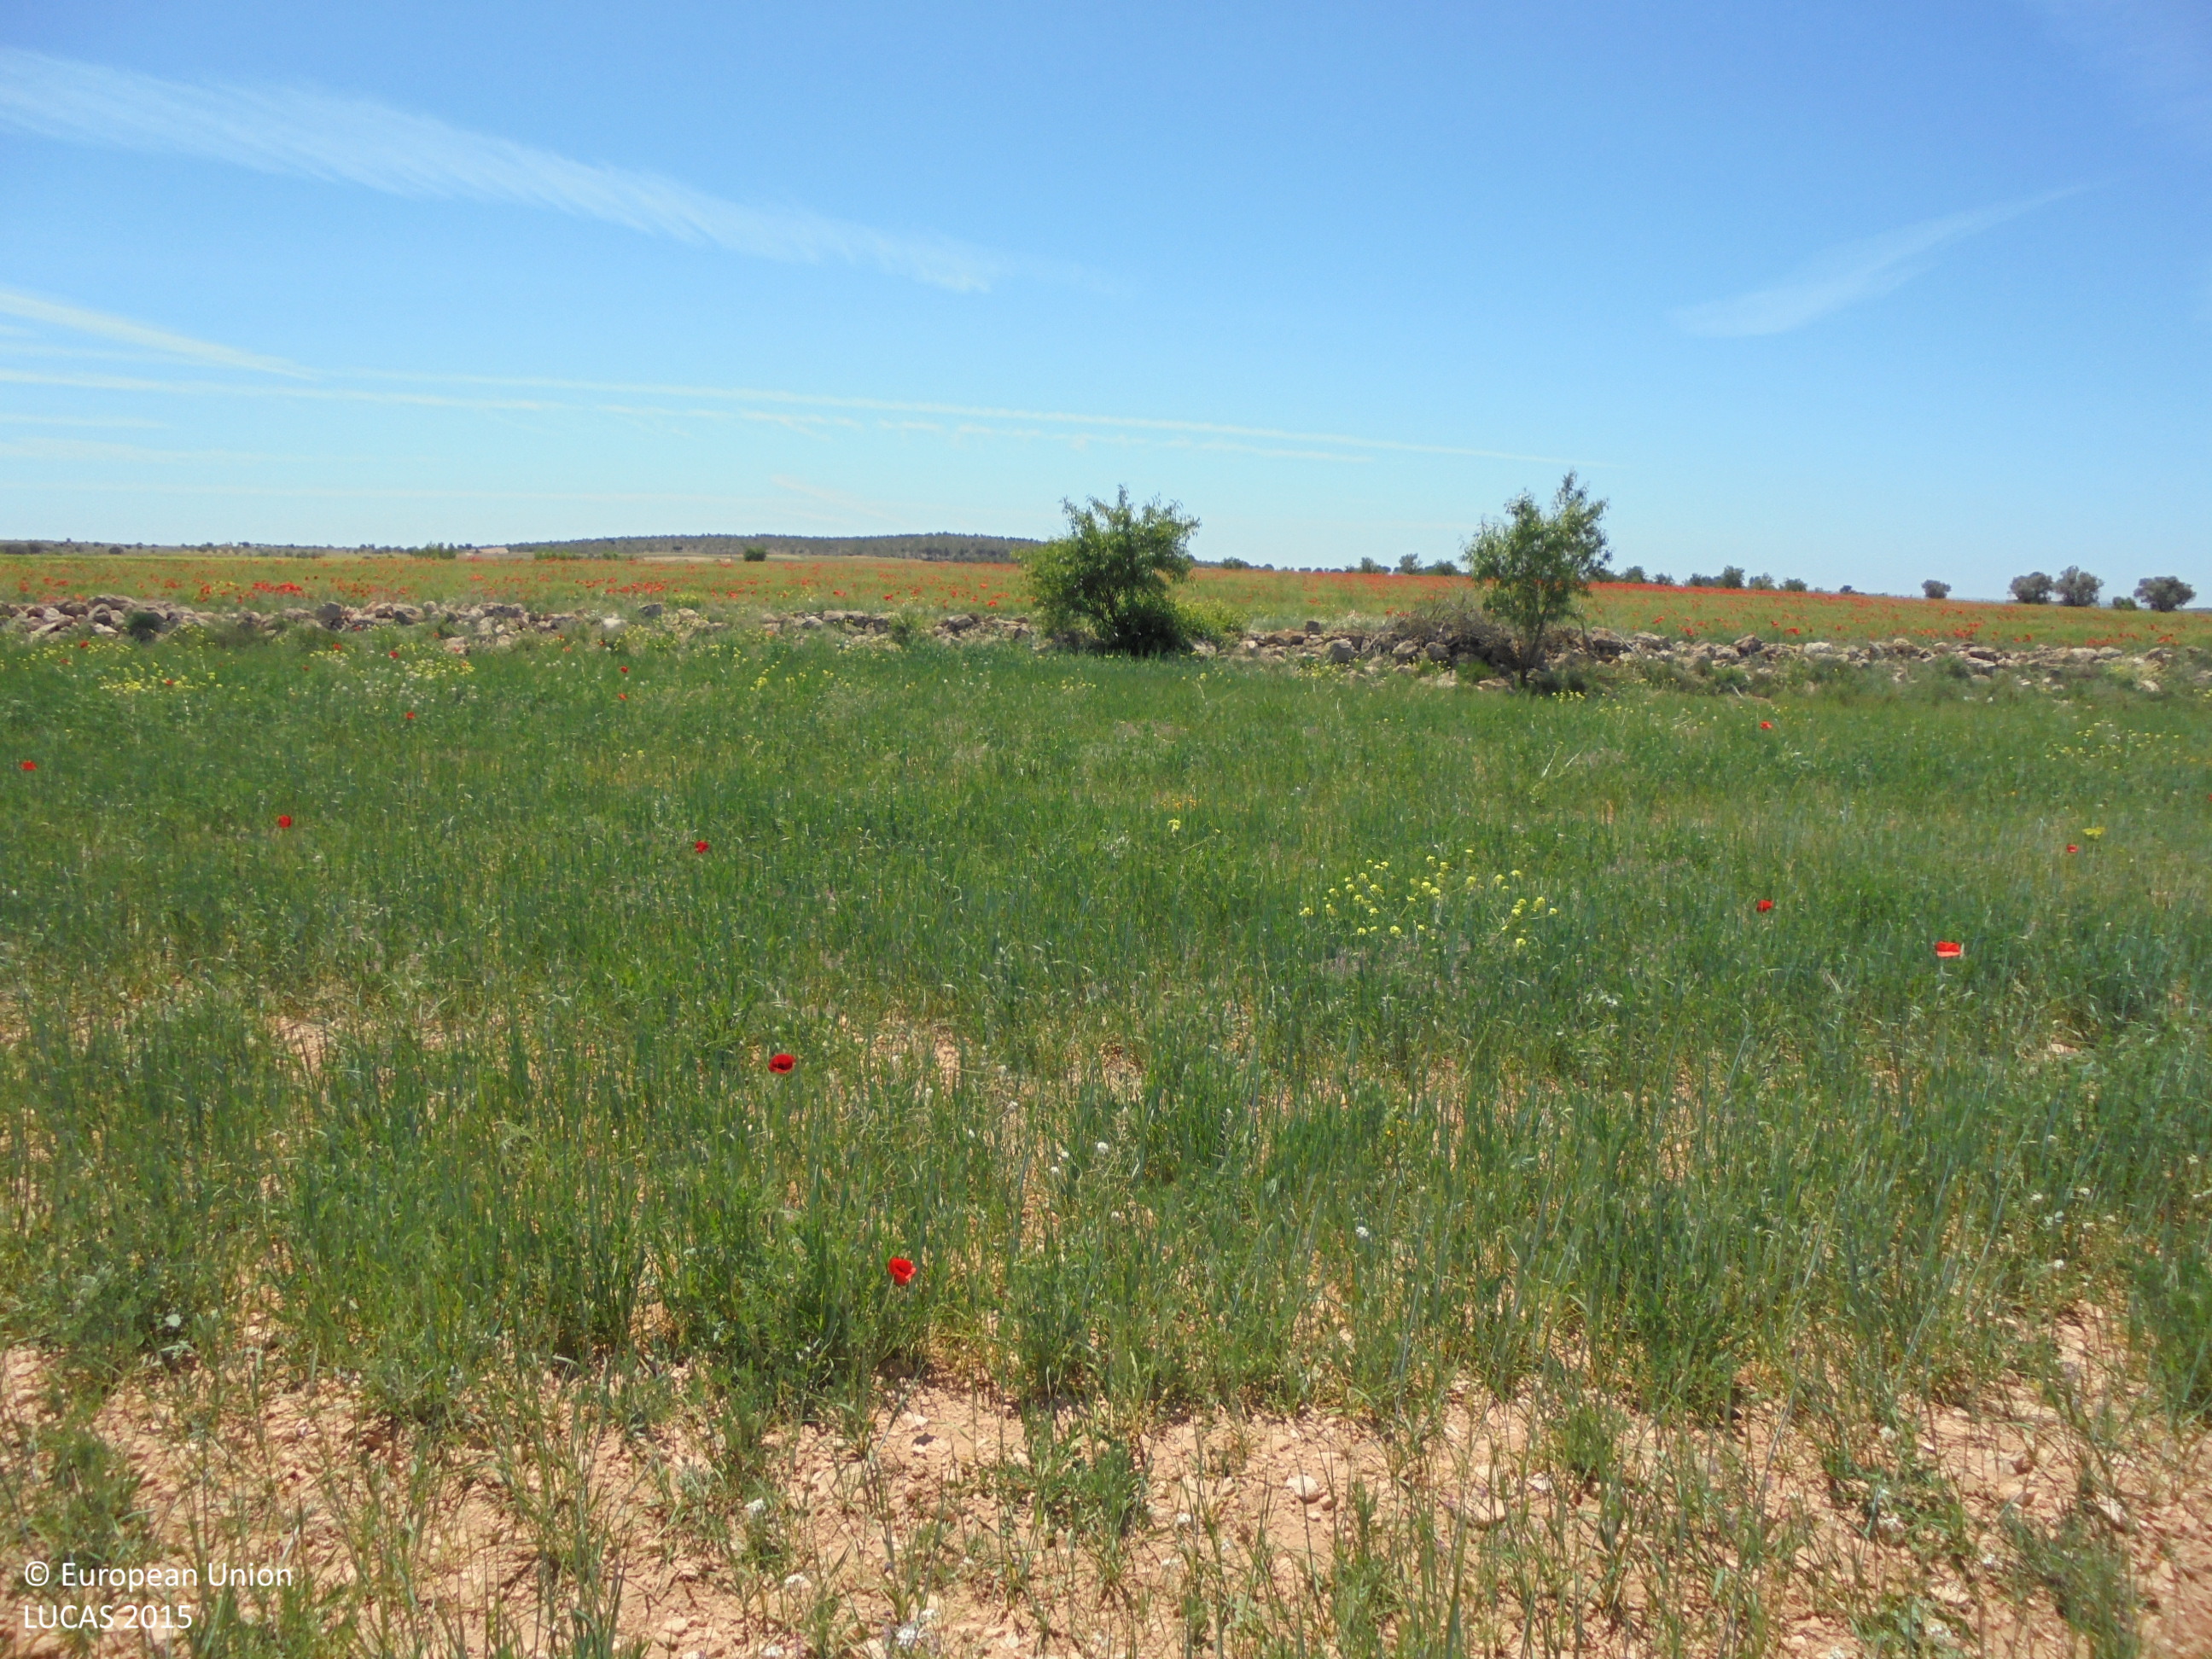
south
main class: Cropland
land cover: Barley
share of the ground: 25 - 50 %
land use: Agriculture (excluding fallow land and kitchen gardens)
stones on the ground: > 50 %
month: May
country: ES
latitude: 39.2768
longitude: -1.5123
